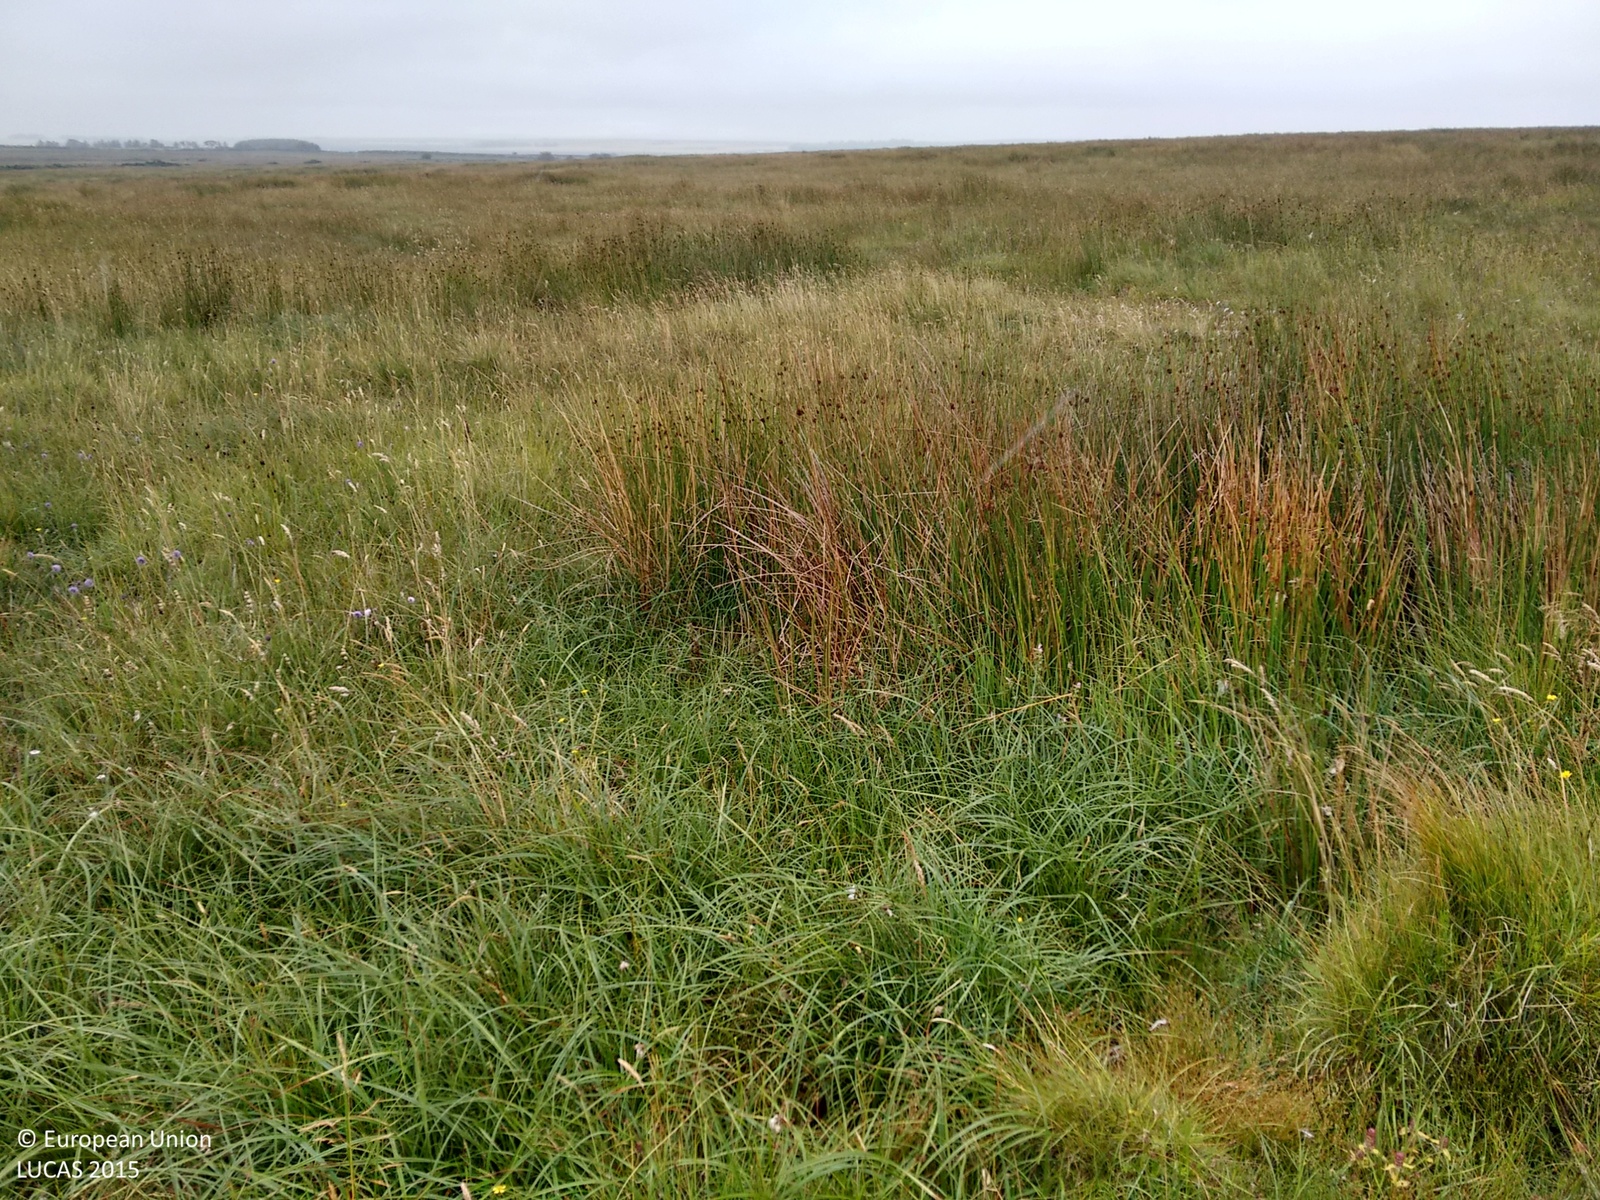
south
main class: Grassland
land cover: Grassland without tree/shrub cover
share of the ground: > 75 %
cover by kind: herbaceous plants 95 %, shrubs 5 %
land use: Agriculture (excluding fallow land and kitchen gardens)
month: August
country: GB
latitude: 58.5617
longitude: -3.2788
